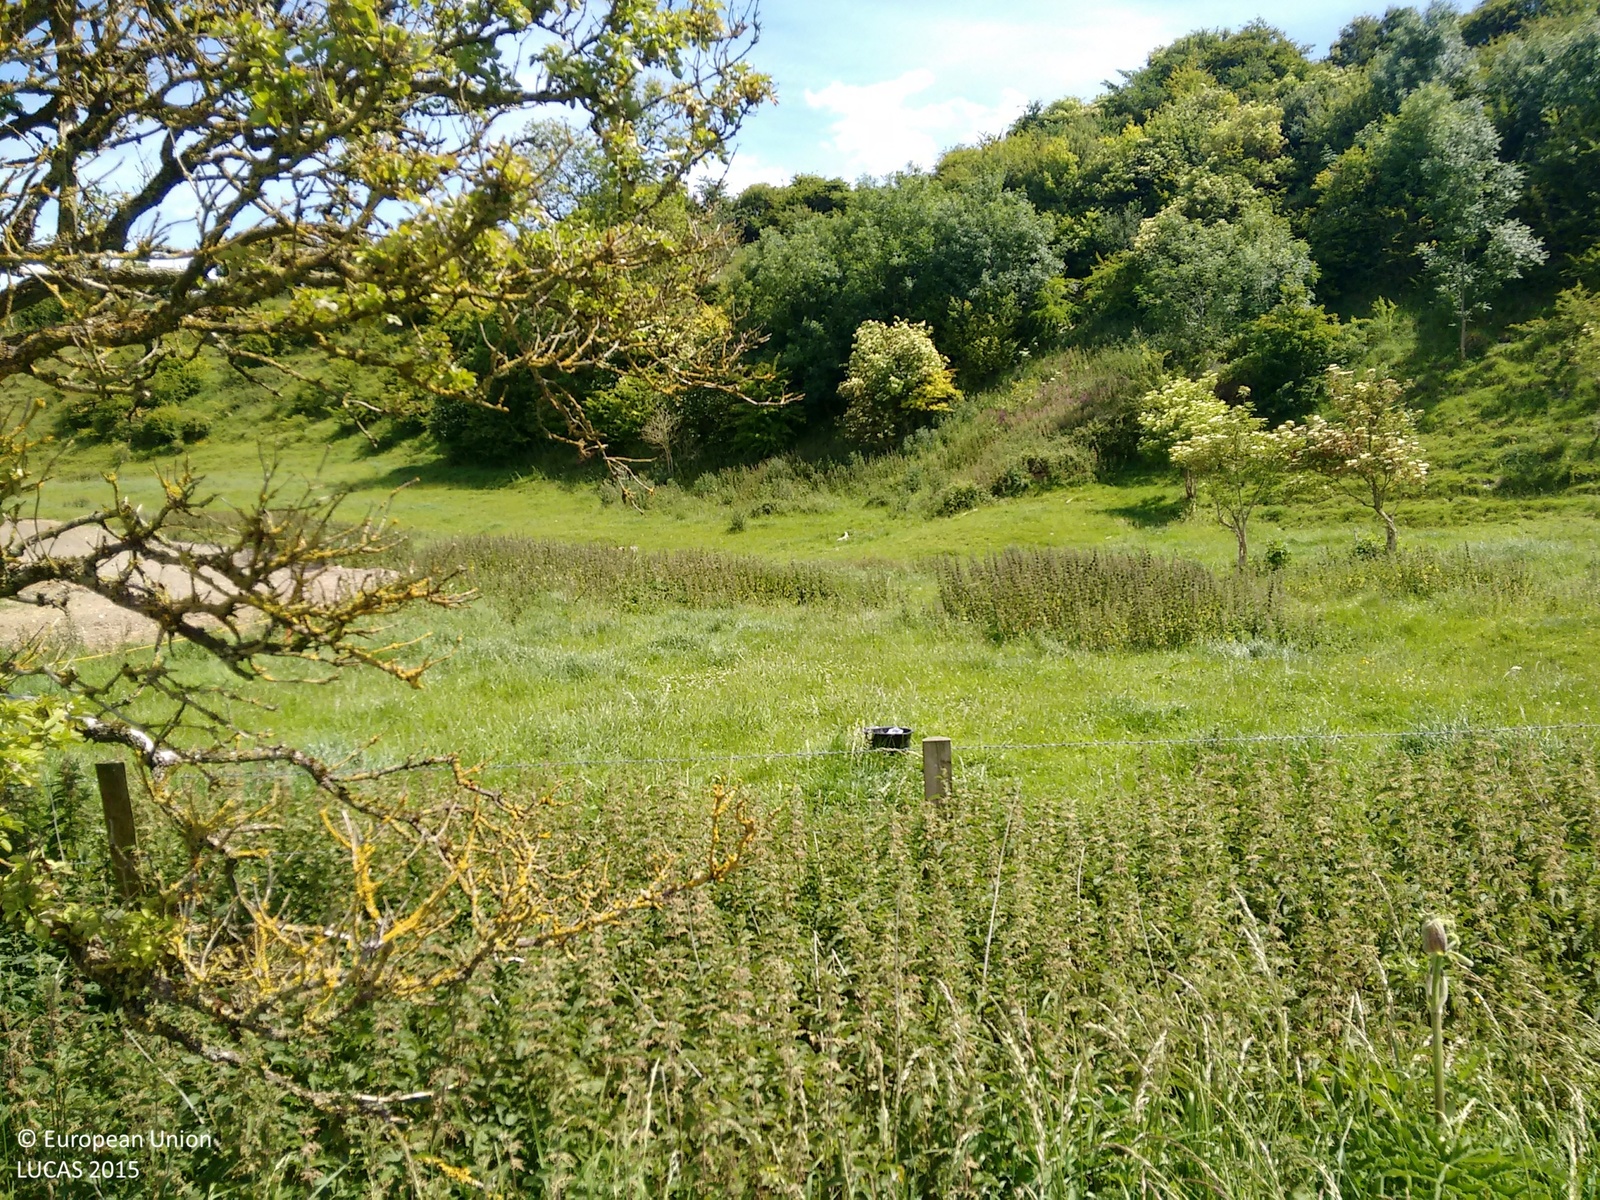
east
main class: Grassland
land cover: Grassland without tree/shrub cover
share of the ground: > 75 %
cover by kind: herbaceous plants 100 %
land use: Agriculture (excluding fallow land and kitchen gardens)
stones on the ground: < 10 %
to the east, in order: Grassland without tree/shrub cover; Fences; Abandoned hedges; Fences; Grassland without tree/shrub cover; Shruby margins; Grassland without tree/shrub cover; Broadleaved woodland; Fences; Shruby margins; Dry pulses
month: June
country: GB
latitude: 51.4845
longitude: -1.9088
